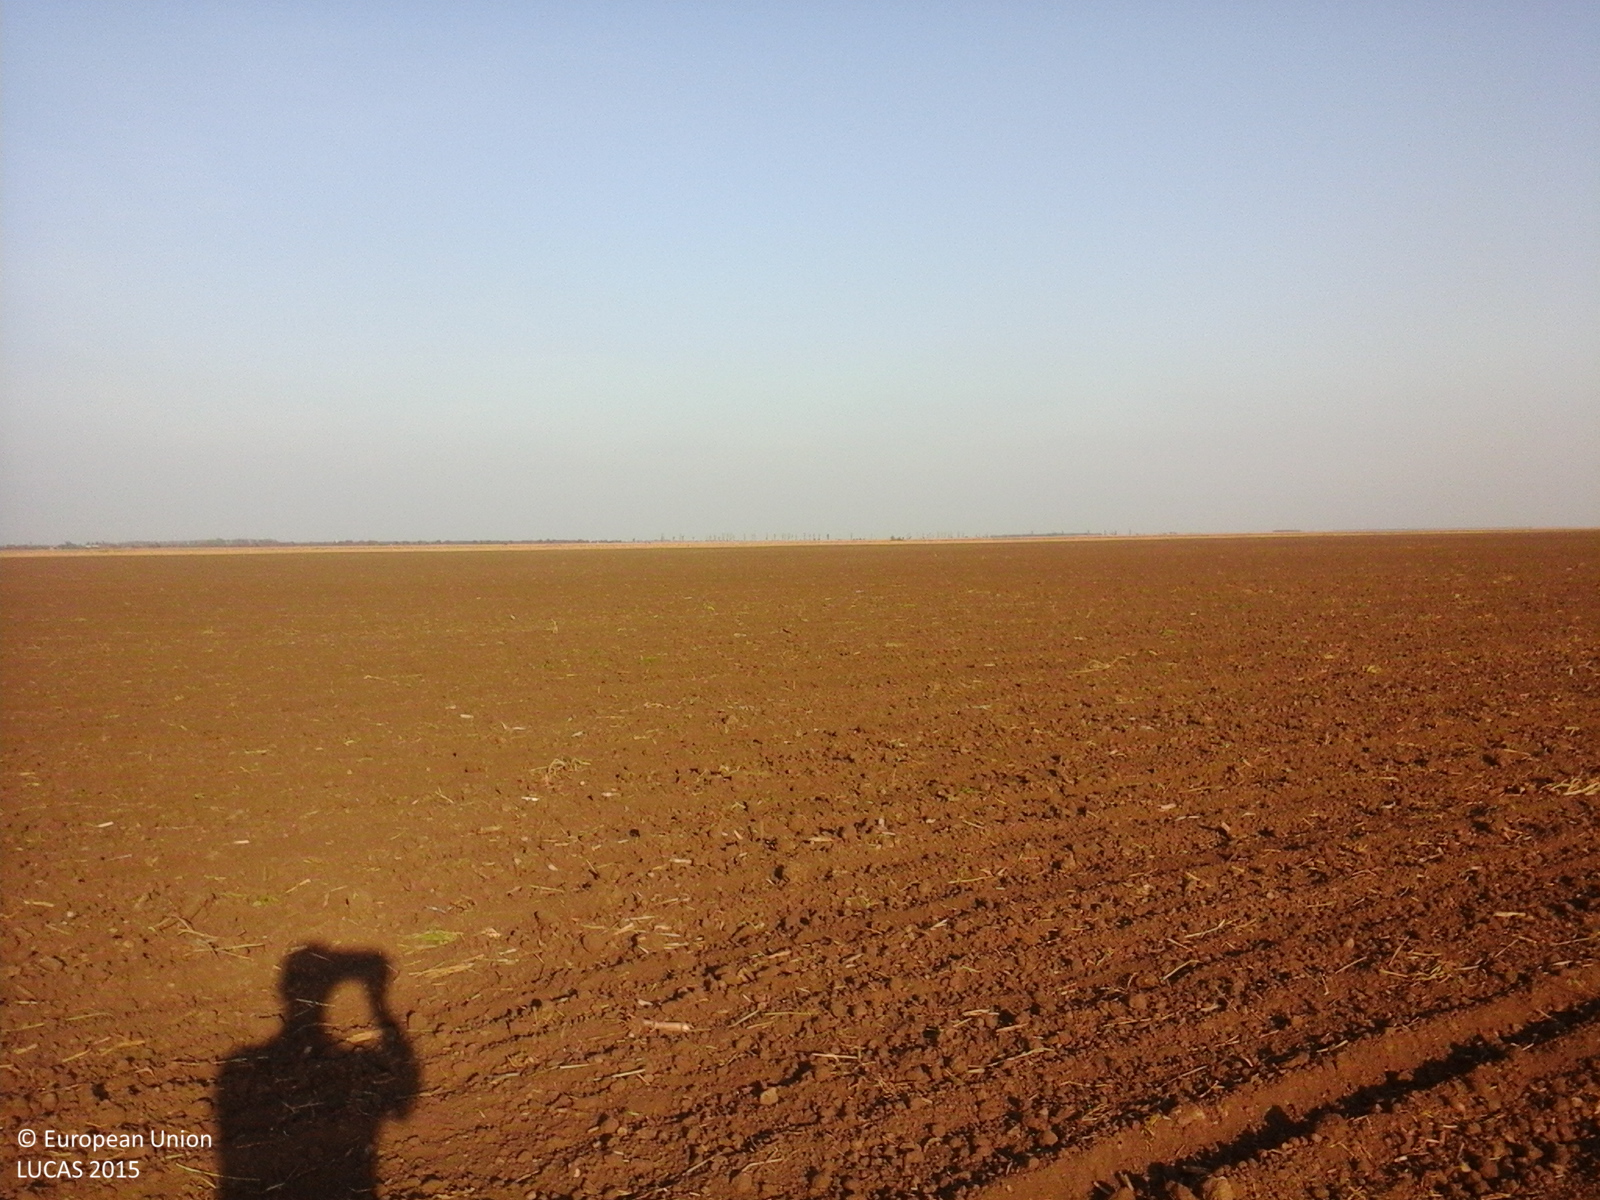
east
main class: Cropland
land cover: Common wheat
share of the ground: < 10 %
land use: Agriculture (excluding fallow land and kitchen gardens)
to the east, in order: Common wheat
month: October
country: RO
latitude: 45.1709
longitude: 26.9423
